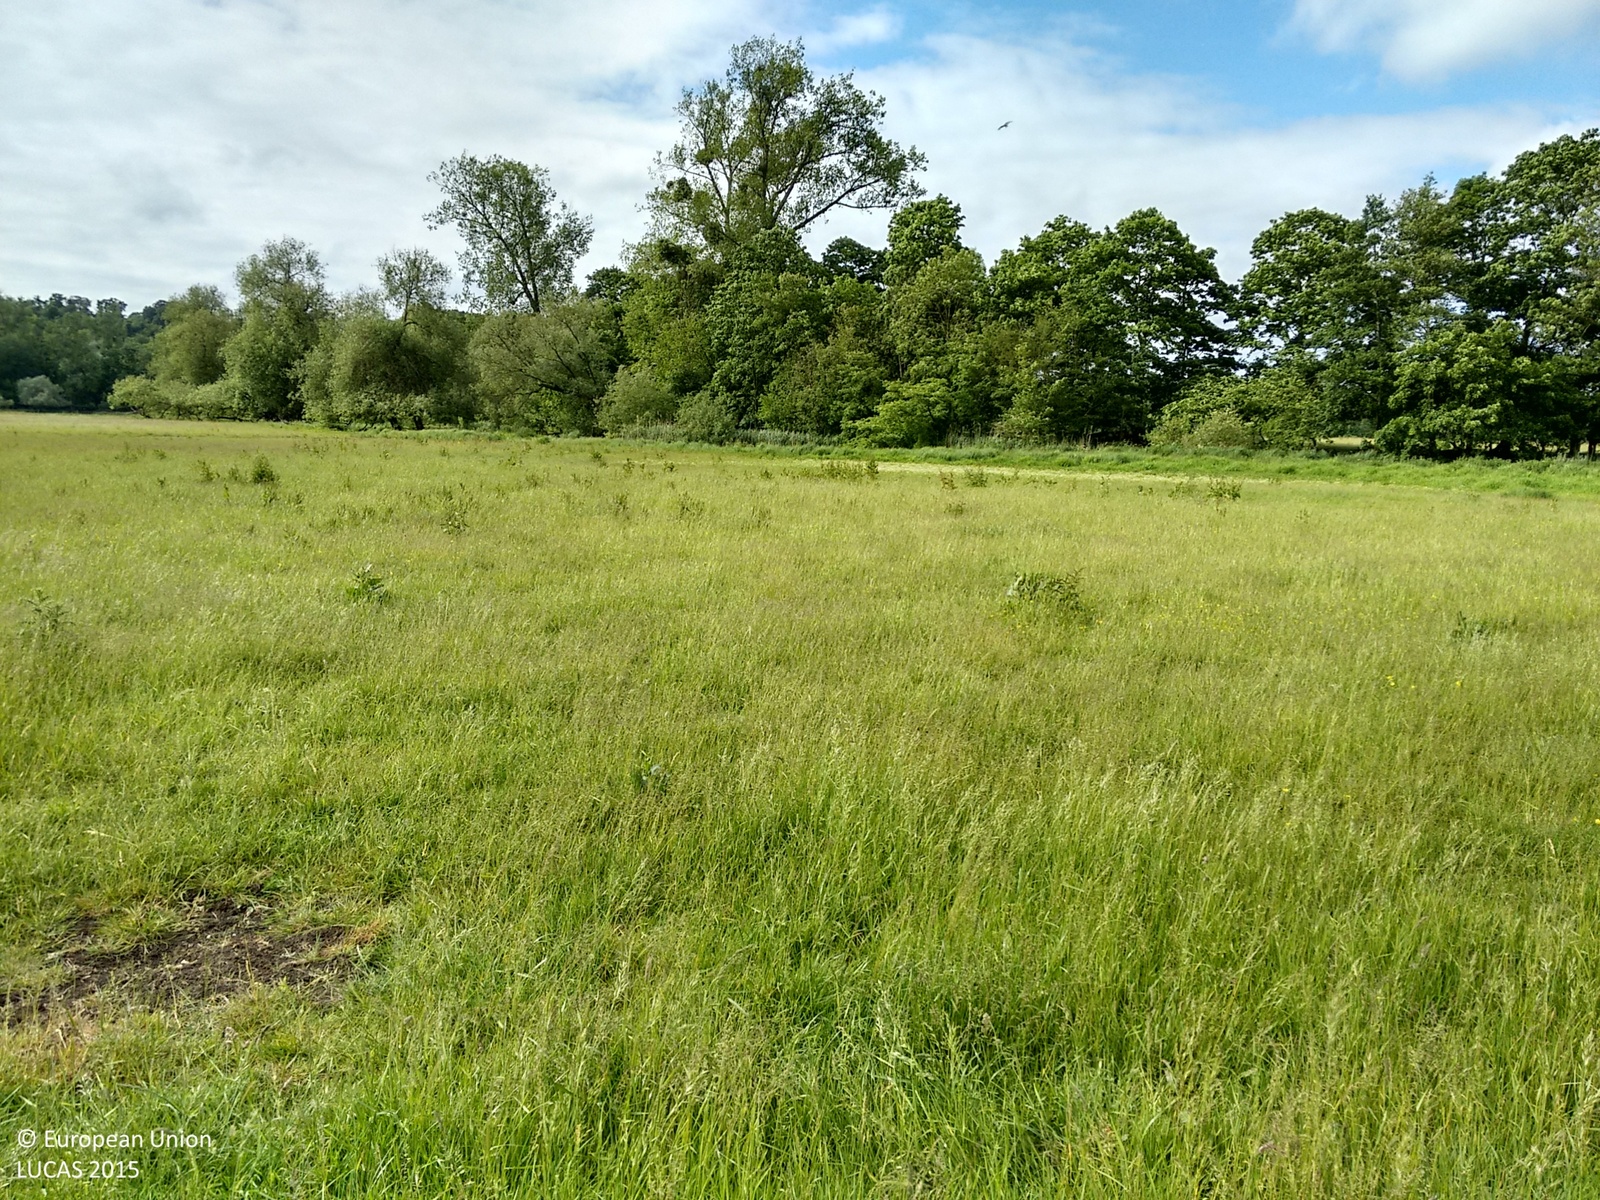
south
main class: Grassland
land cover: Grassland without tree/shrub cover
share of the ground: > 75 %
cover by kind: herbaceous plants 100 %
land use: Agriculture (excluding fallow land and kitchen gardens)
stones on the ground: < 10 %
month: June
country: GB
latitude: 51.5479
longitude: -0.6976
